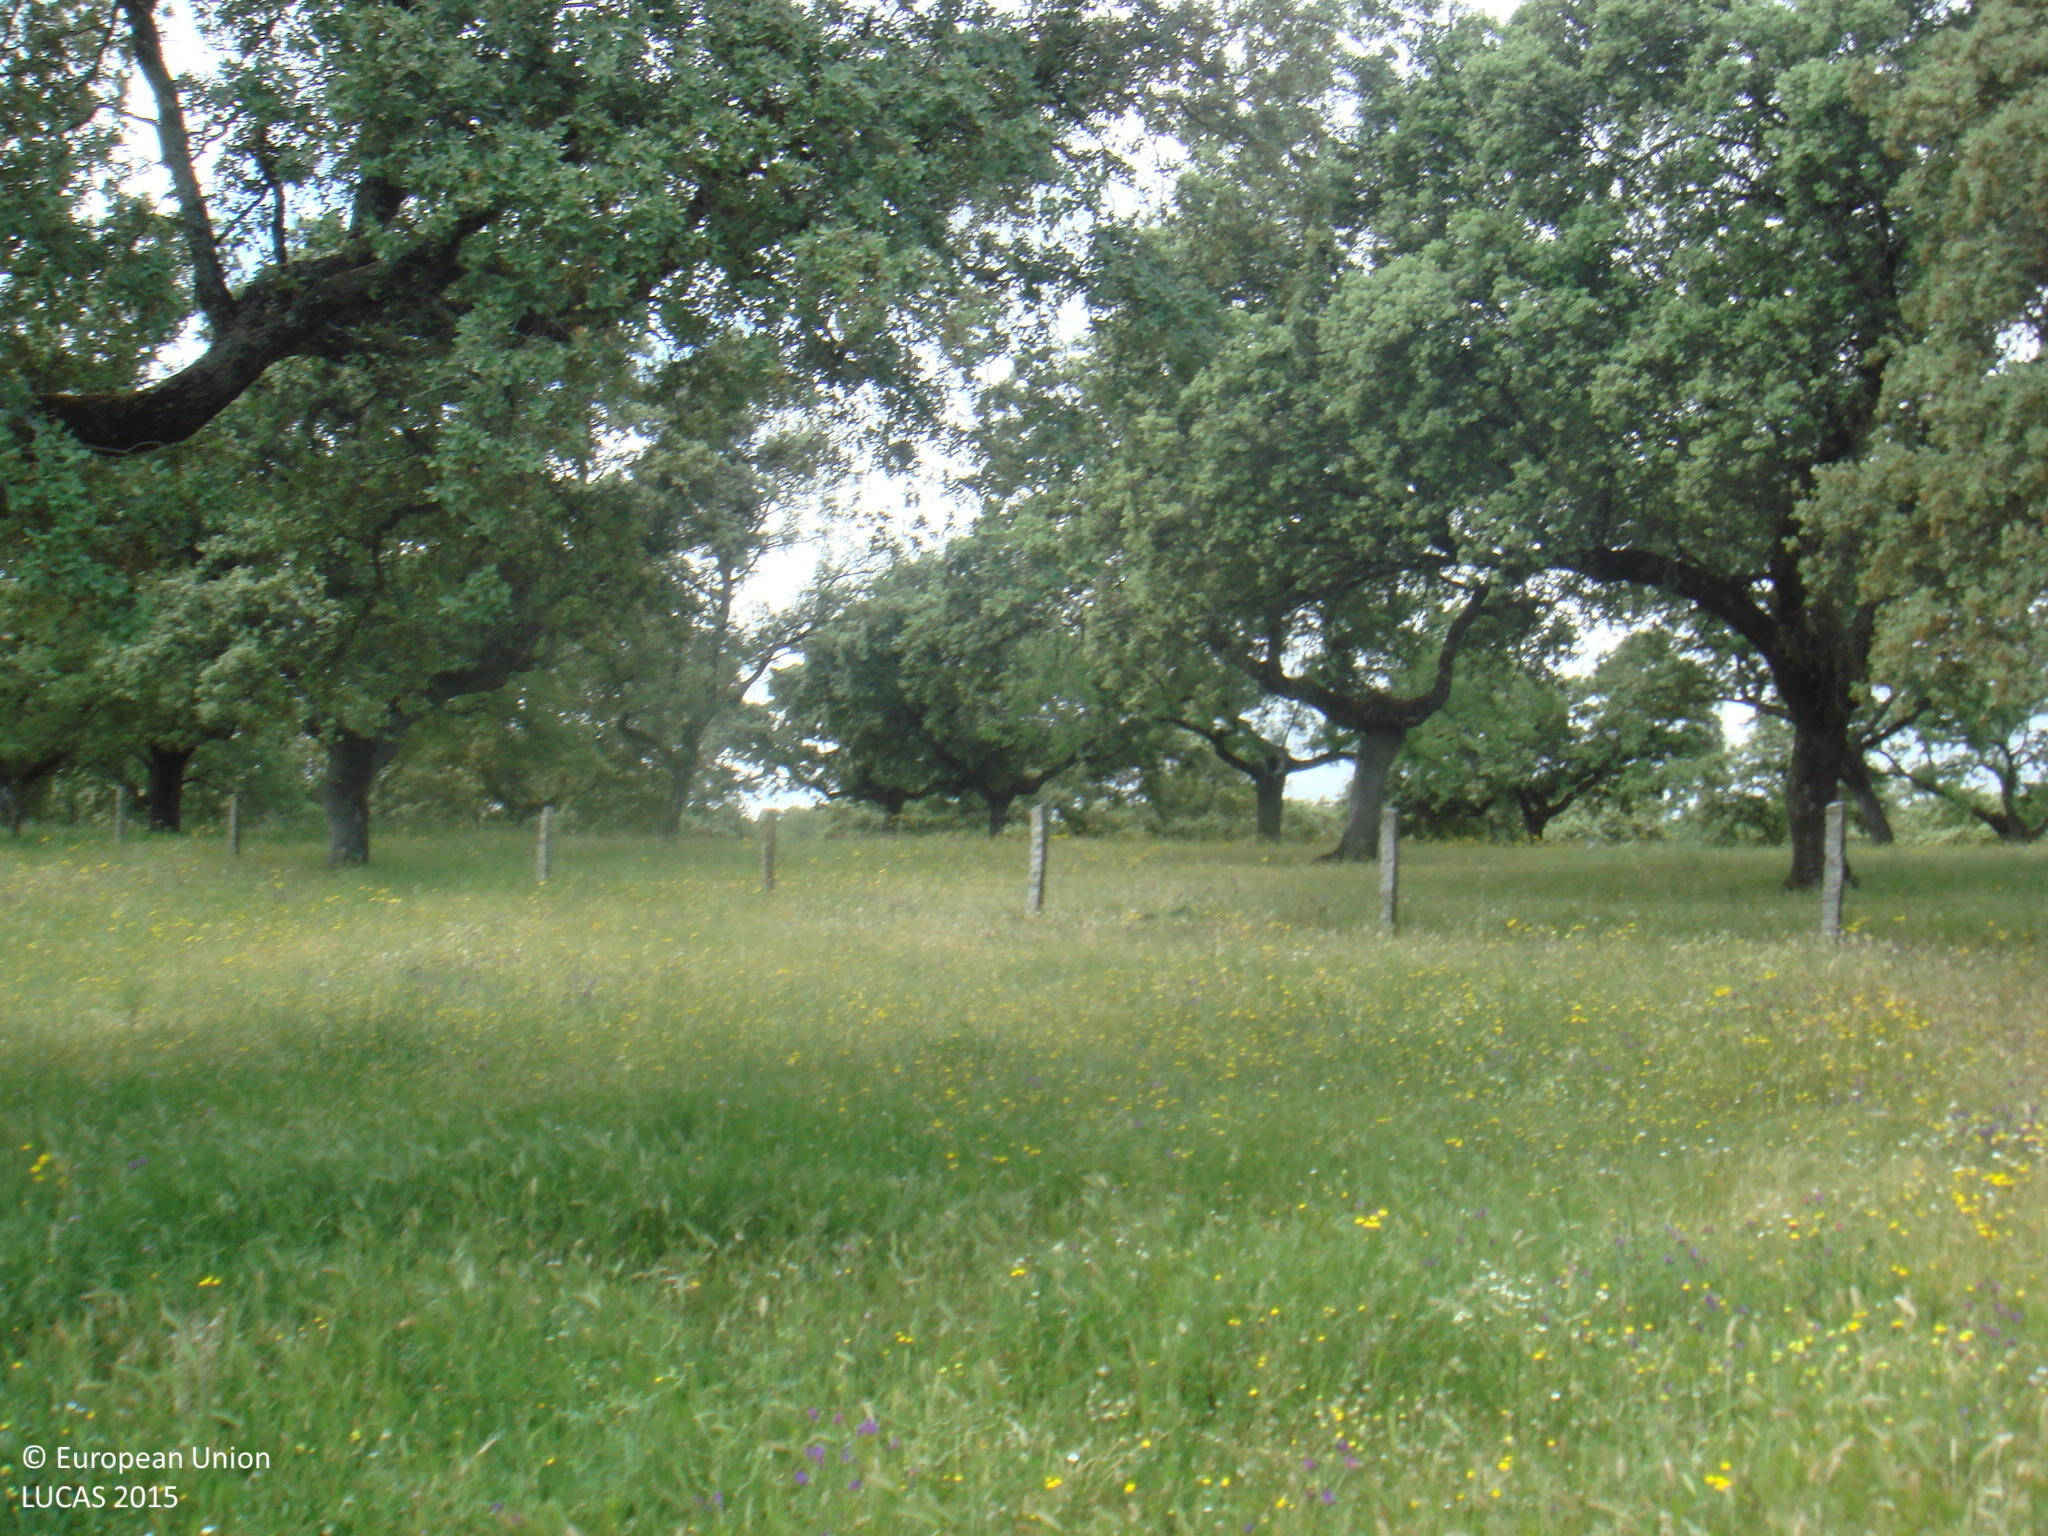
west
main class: Woodland
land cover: Broadleaved woodland
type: broadleaved evergreen forest
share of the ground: 10 - 25 %
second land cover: Spontaneously vegetated surfaces
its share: > 75 %
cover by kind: herbaceous plants 80 %, broadleaved forest trees 20 %
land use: Forestry
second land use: Agriculture (excluding fallow land and kitchen gardens)
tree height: > 5 m
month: May
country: ES
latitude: 38.2899
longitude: -4.3410
